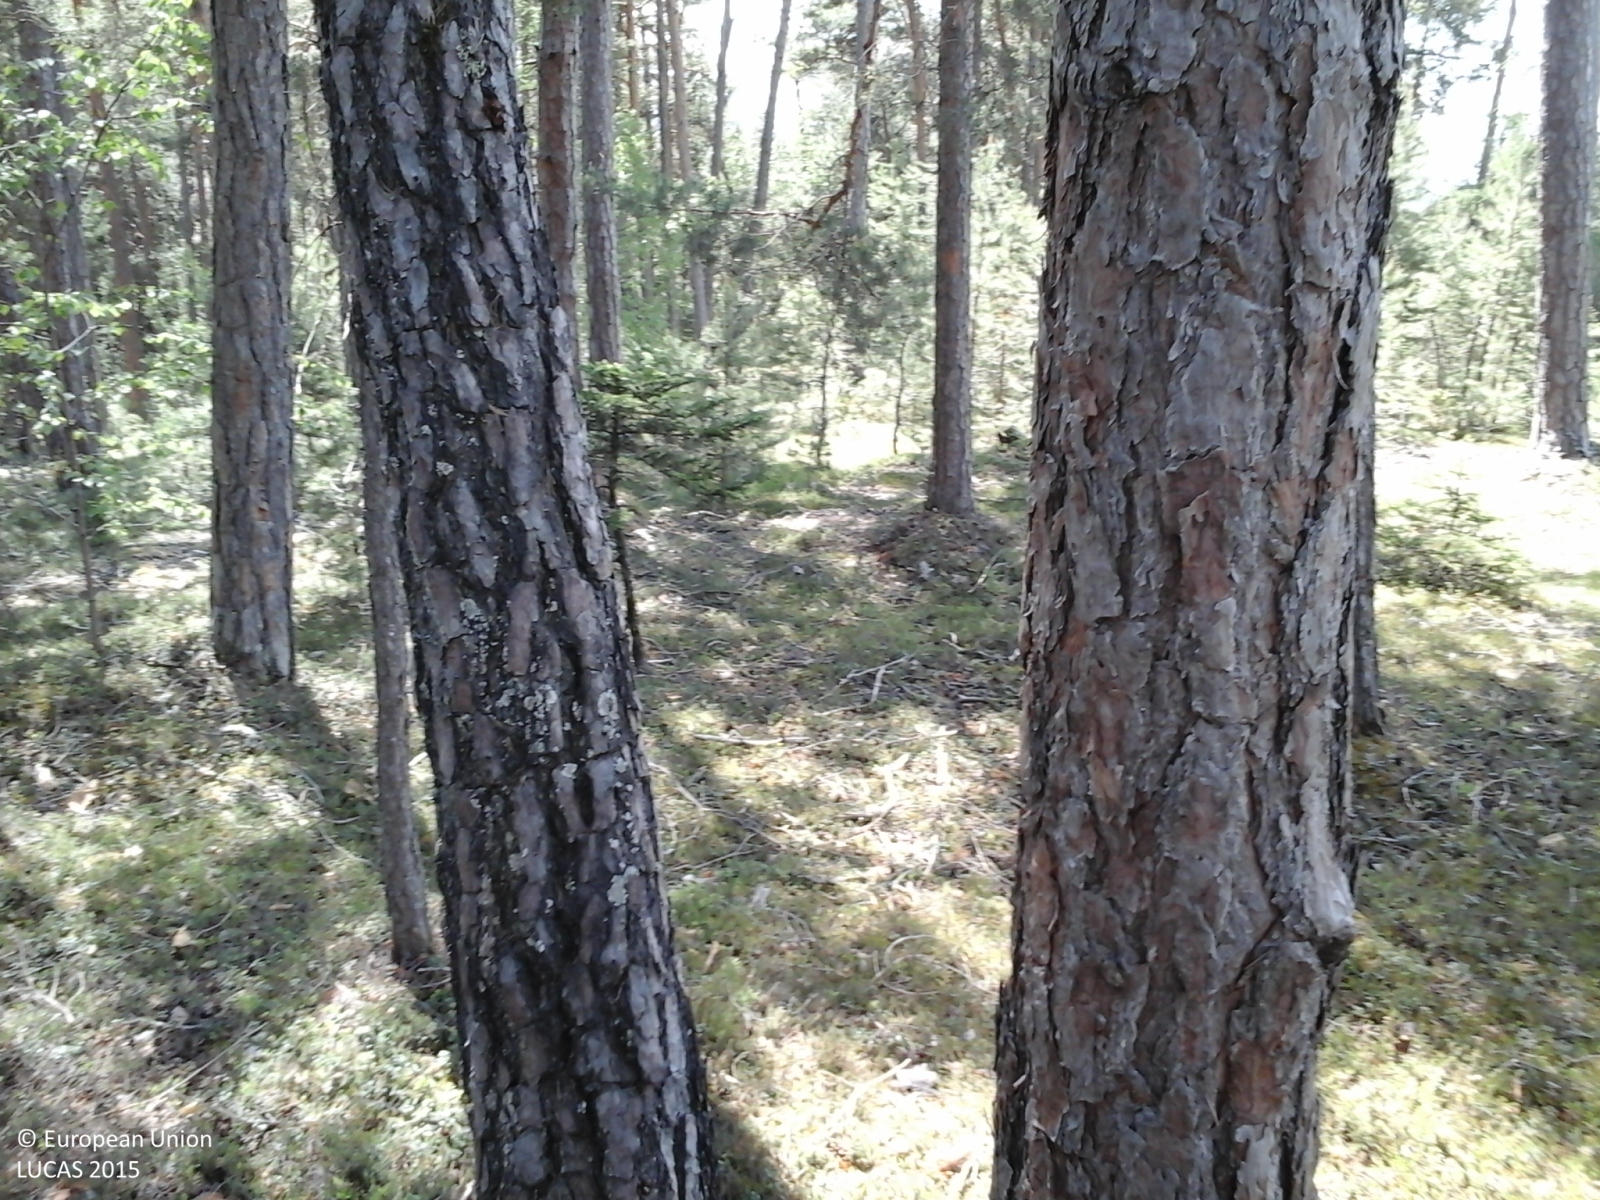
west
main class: Woodland
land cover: Pine dominated coniferous woodland
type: alpine coniferous forest
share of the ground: > 75 %
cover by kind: coniferous forest trees 100 %
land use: Forestry
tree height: > 5 m
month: May
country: IT
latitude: 46.5738
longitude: 11.5770
